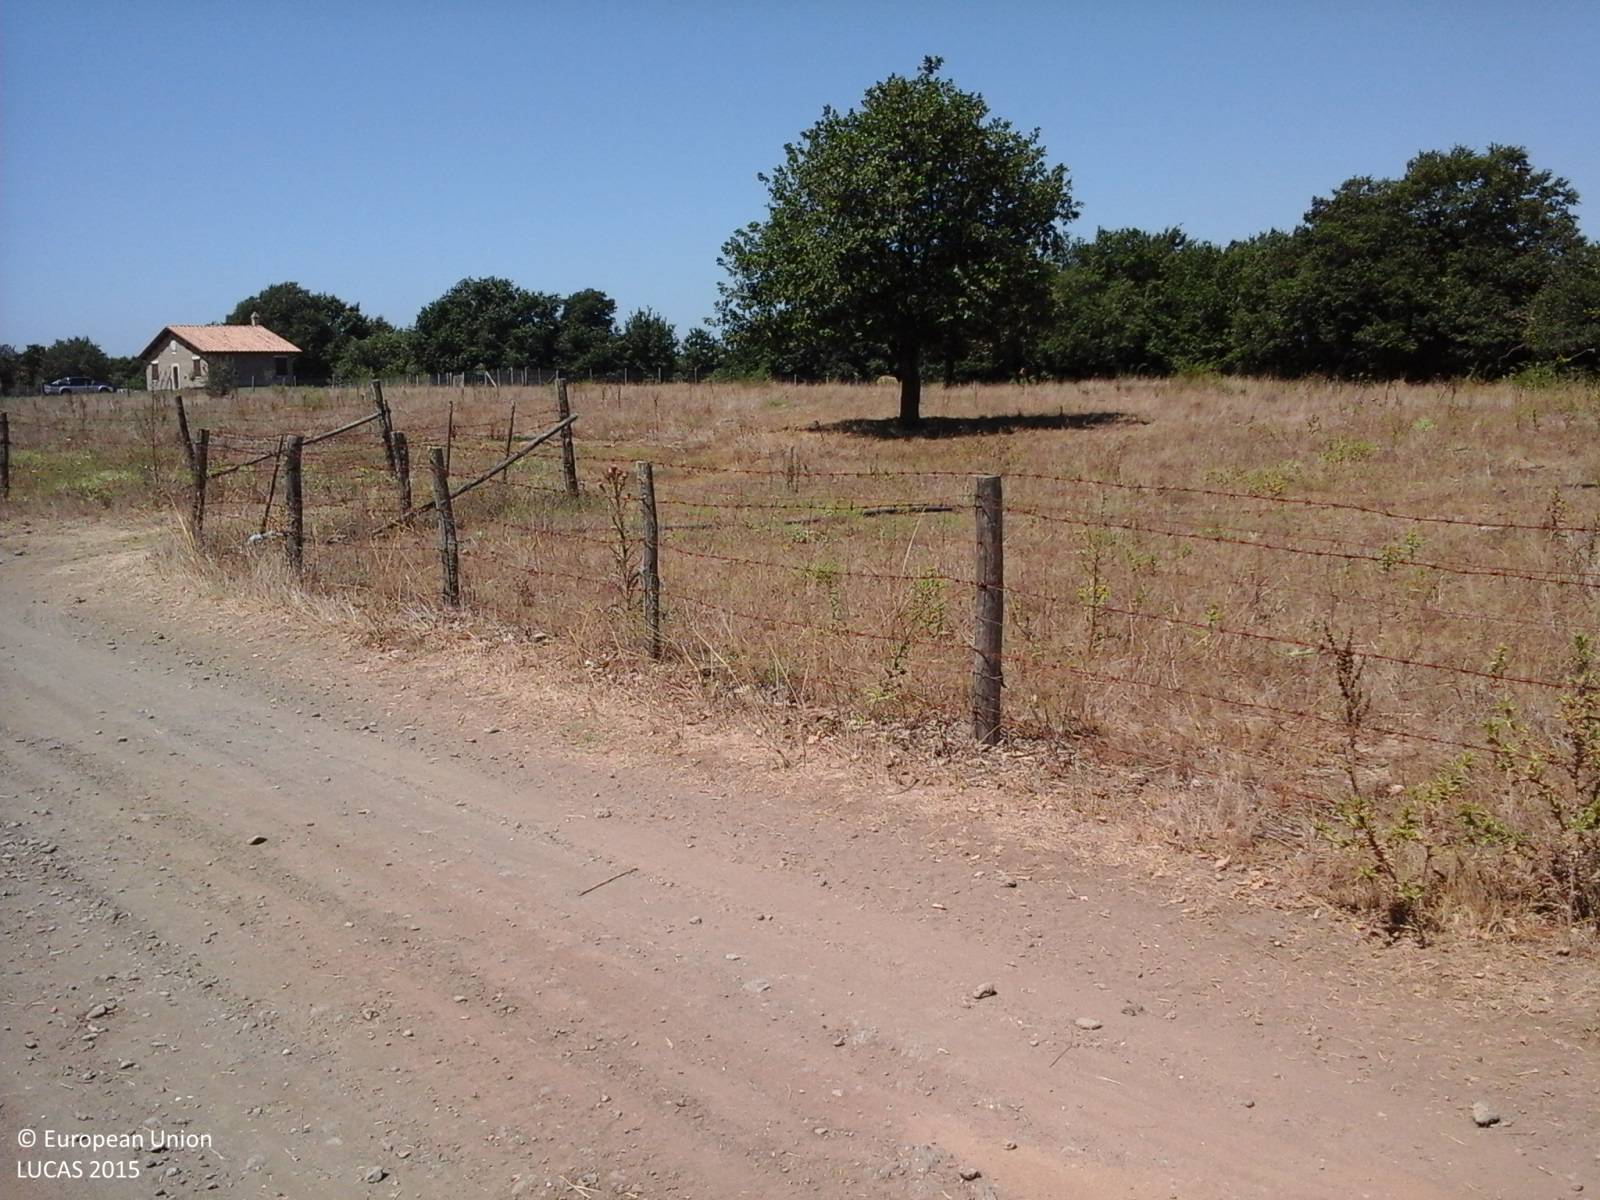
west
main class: Grassland
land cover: Grassland with sparse tree/shrub cover
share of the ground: > 75 %
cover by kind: herbaceous plants 60 %, unconsolidated bare surface 35 %, broadleaved forest trees 5 %
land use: Agriculture (excluding fallow land and kitchen gardens)
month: July
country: IT
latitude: 42.2116
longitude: 12.3296
